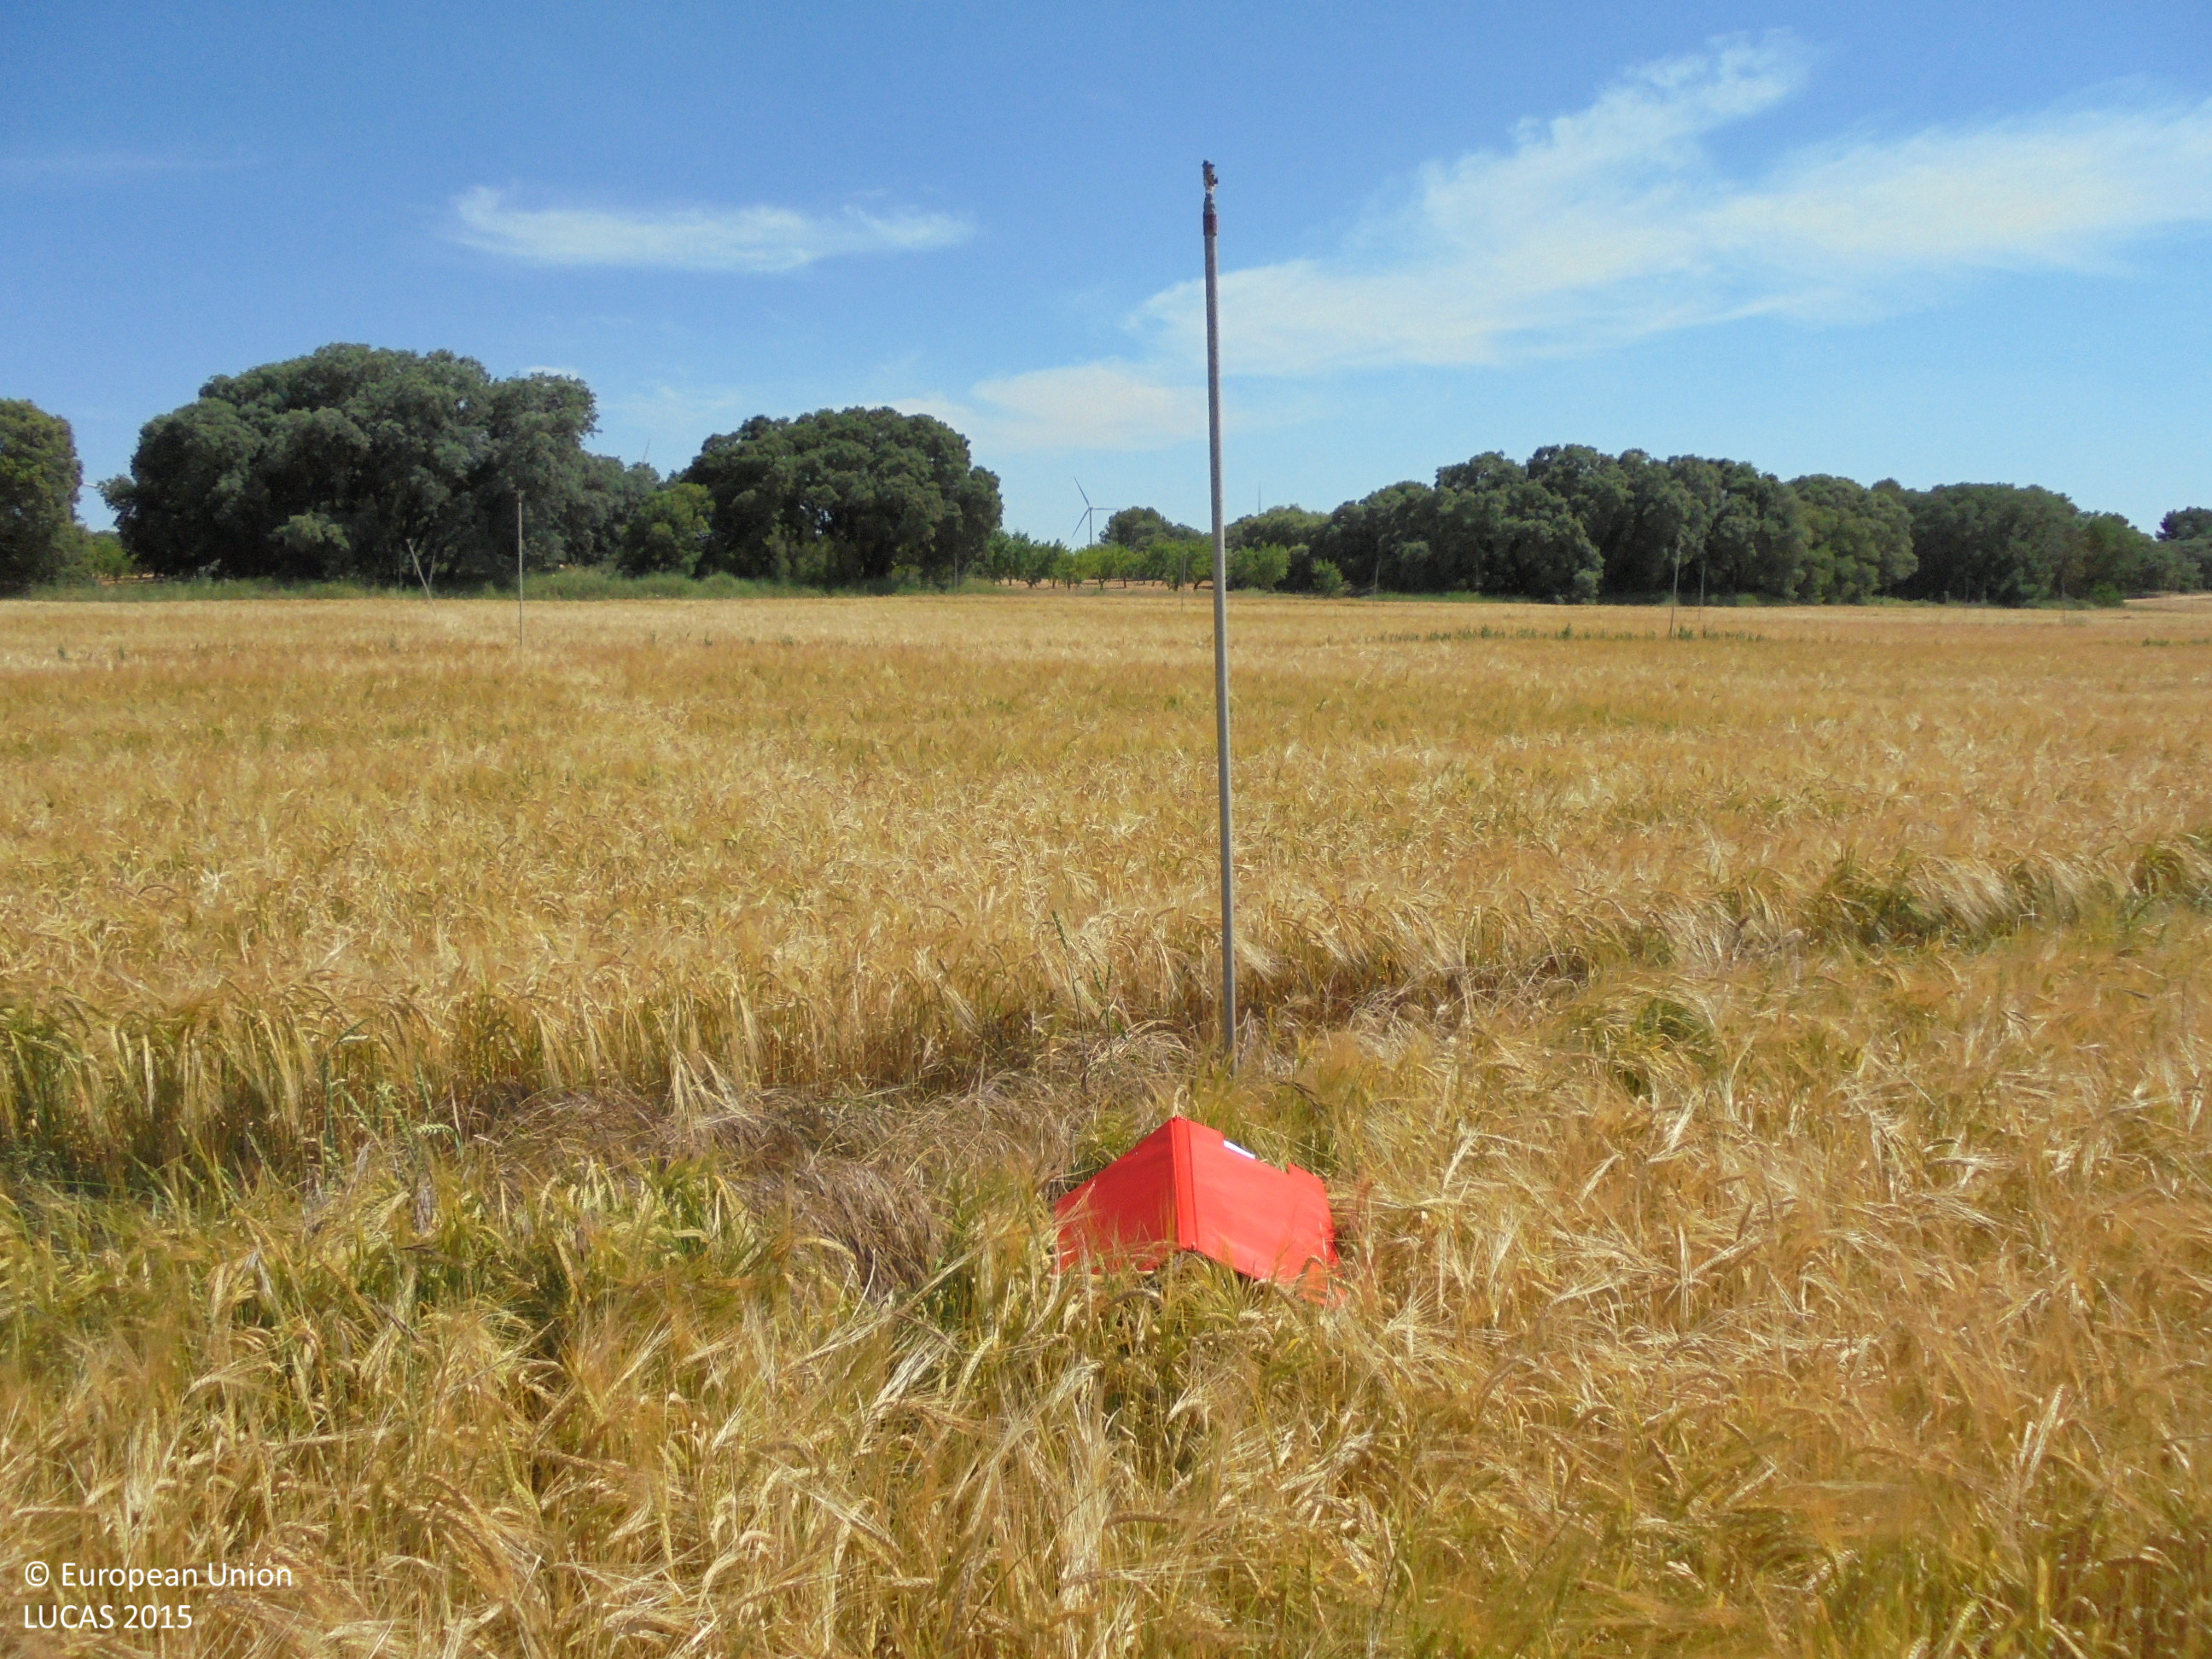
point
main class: Cropland
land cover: Barley
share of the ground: > 75 %
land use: Agriculture (excluding fallow land and kitchen gardens)
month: June
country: ES
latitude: 38.7593
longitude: -1.5609
